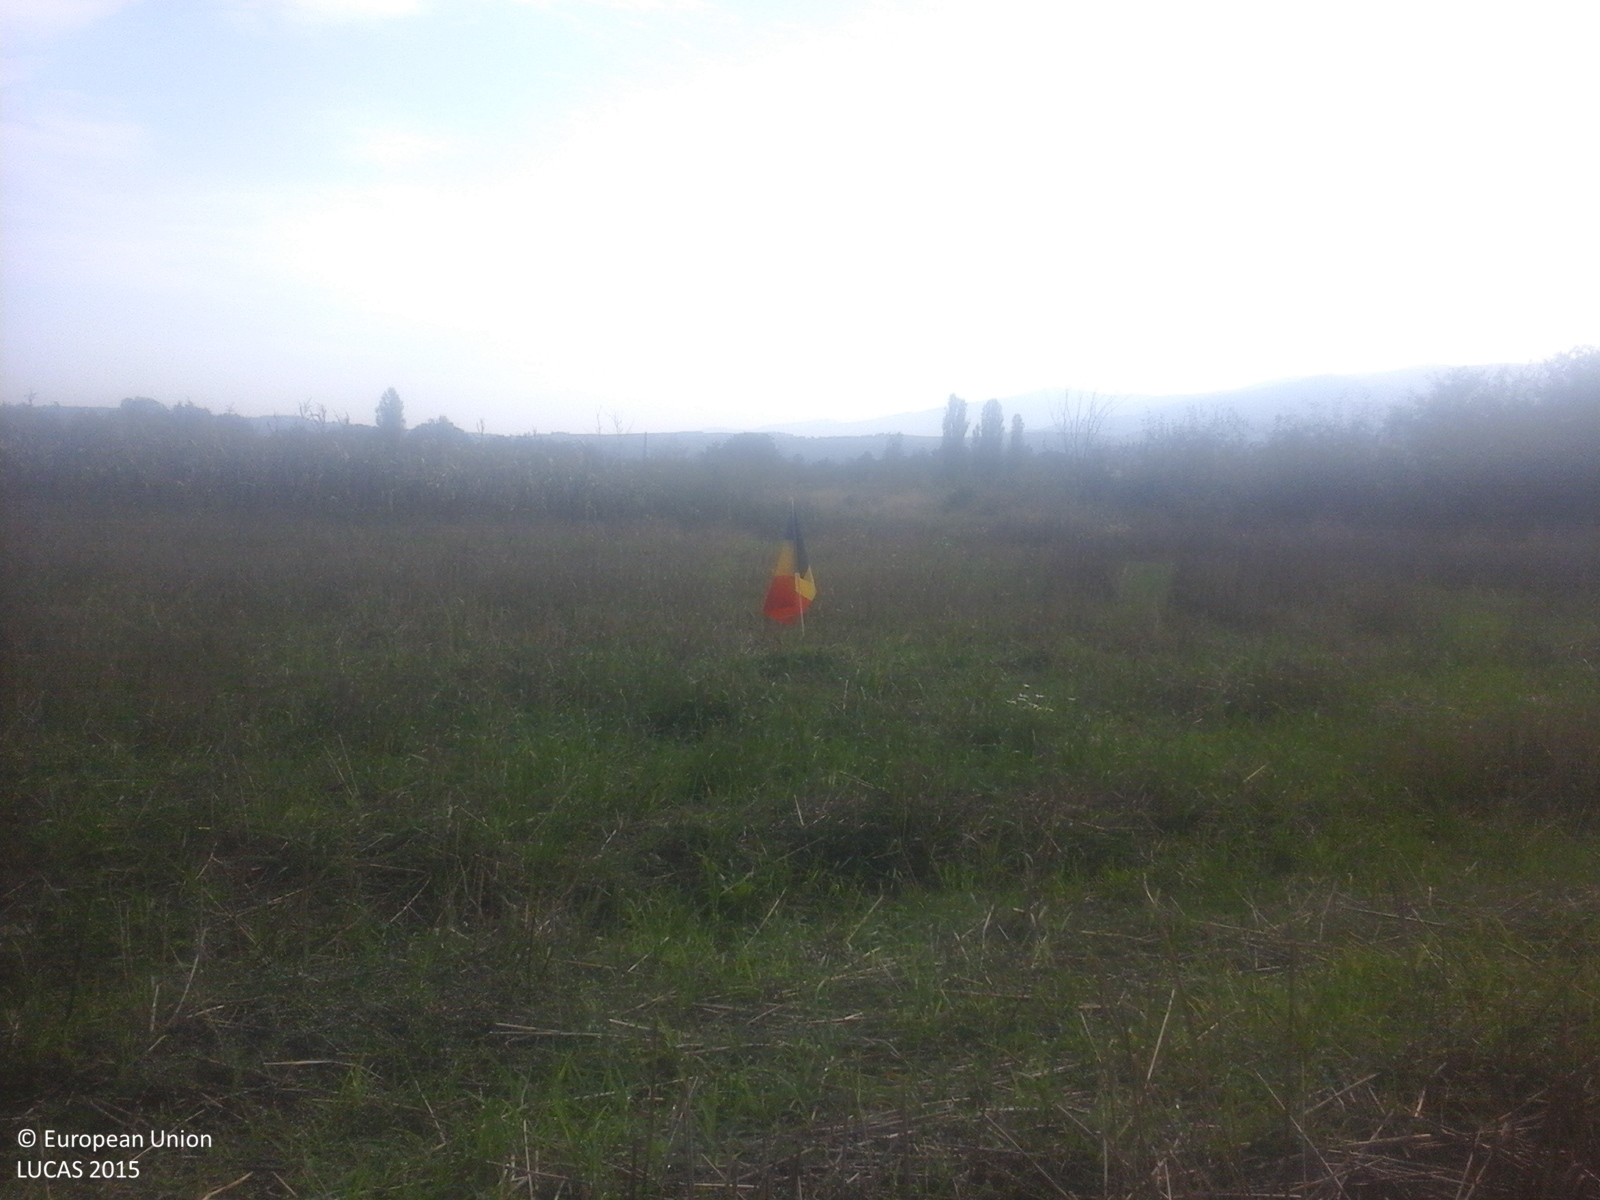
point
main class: Cropland
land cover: Common wheat
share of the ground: 50 - 75 %
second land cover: Spontaneously vegetated surfaces
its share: 50 - 75 %
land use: Agriculture (excluding fallow land and kitchen gardens)
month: September
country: RO
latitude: 45.5189
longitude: 22.8396
